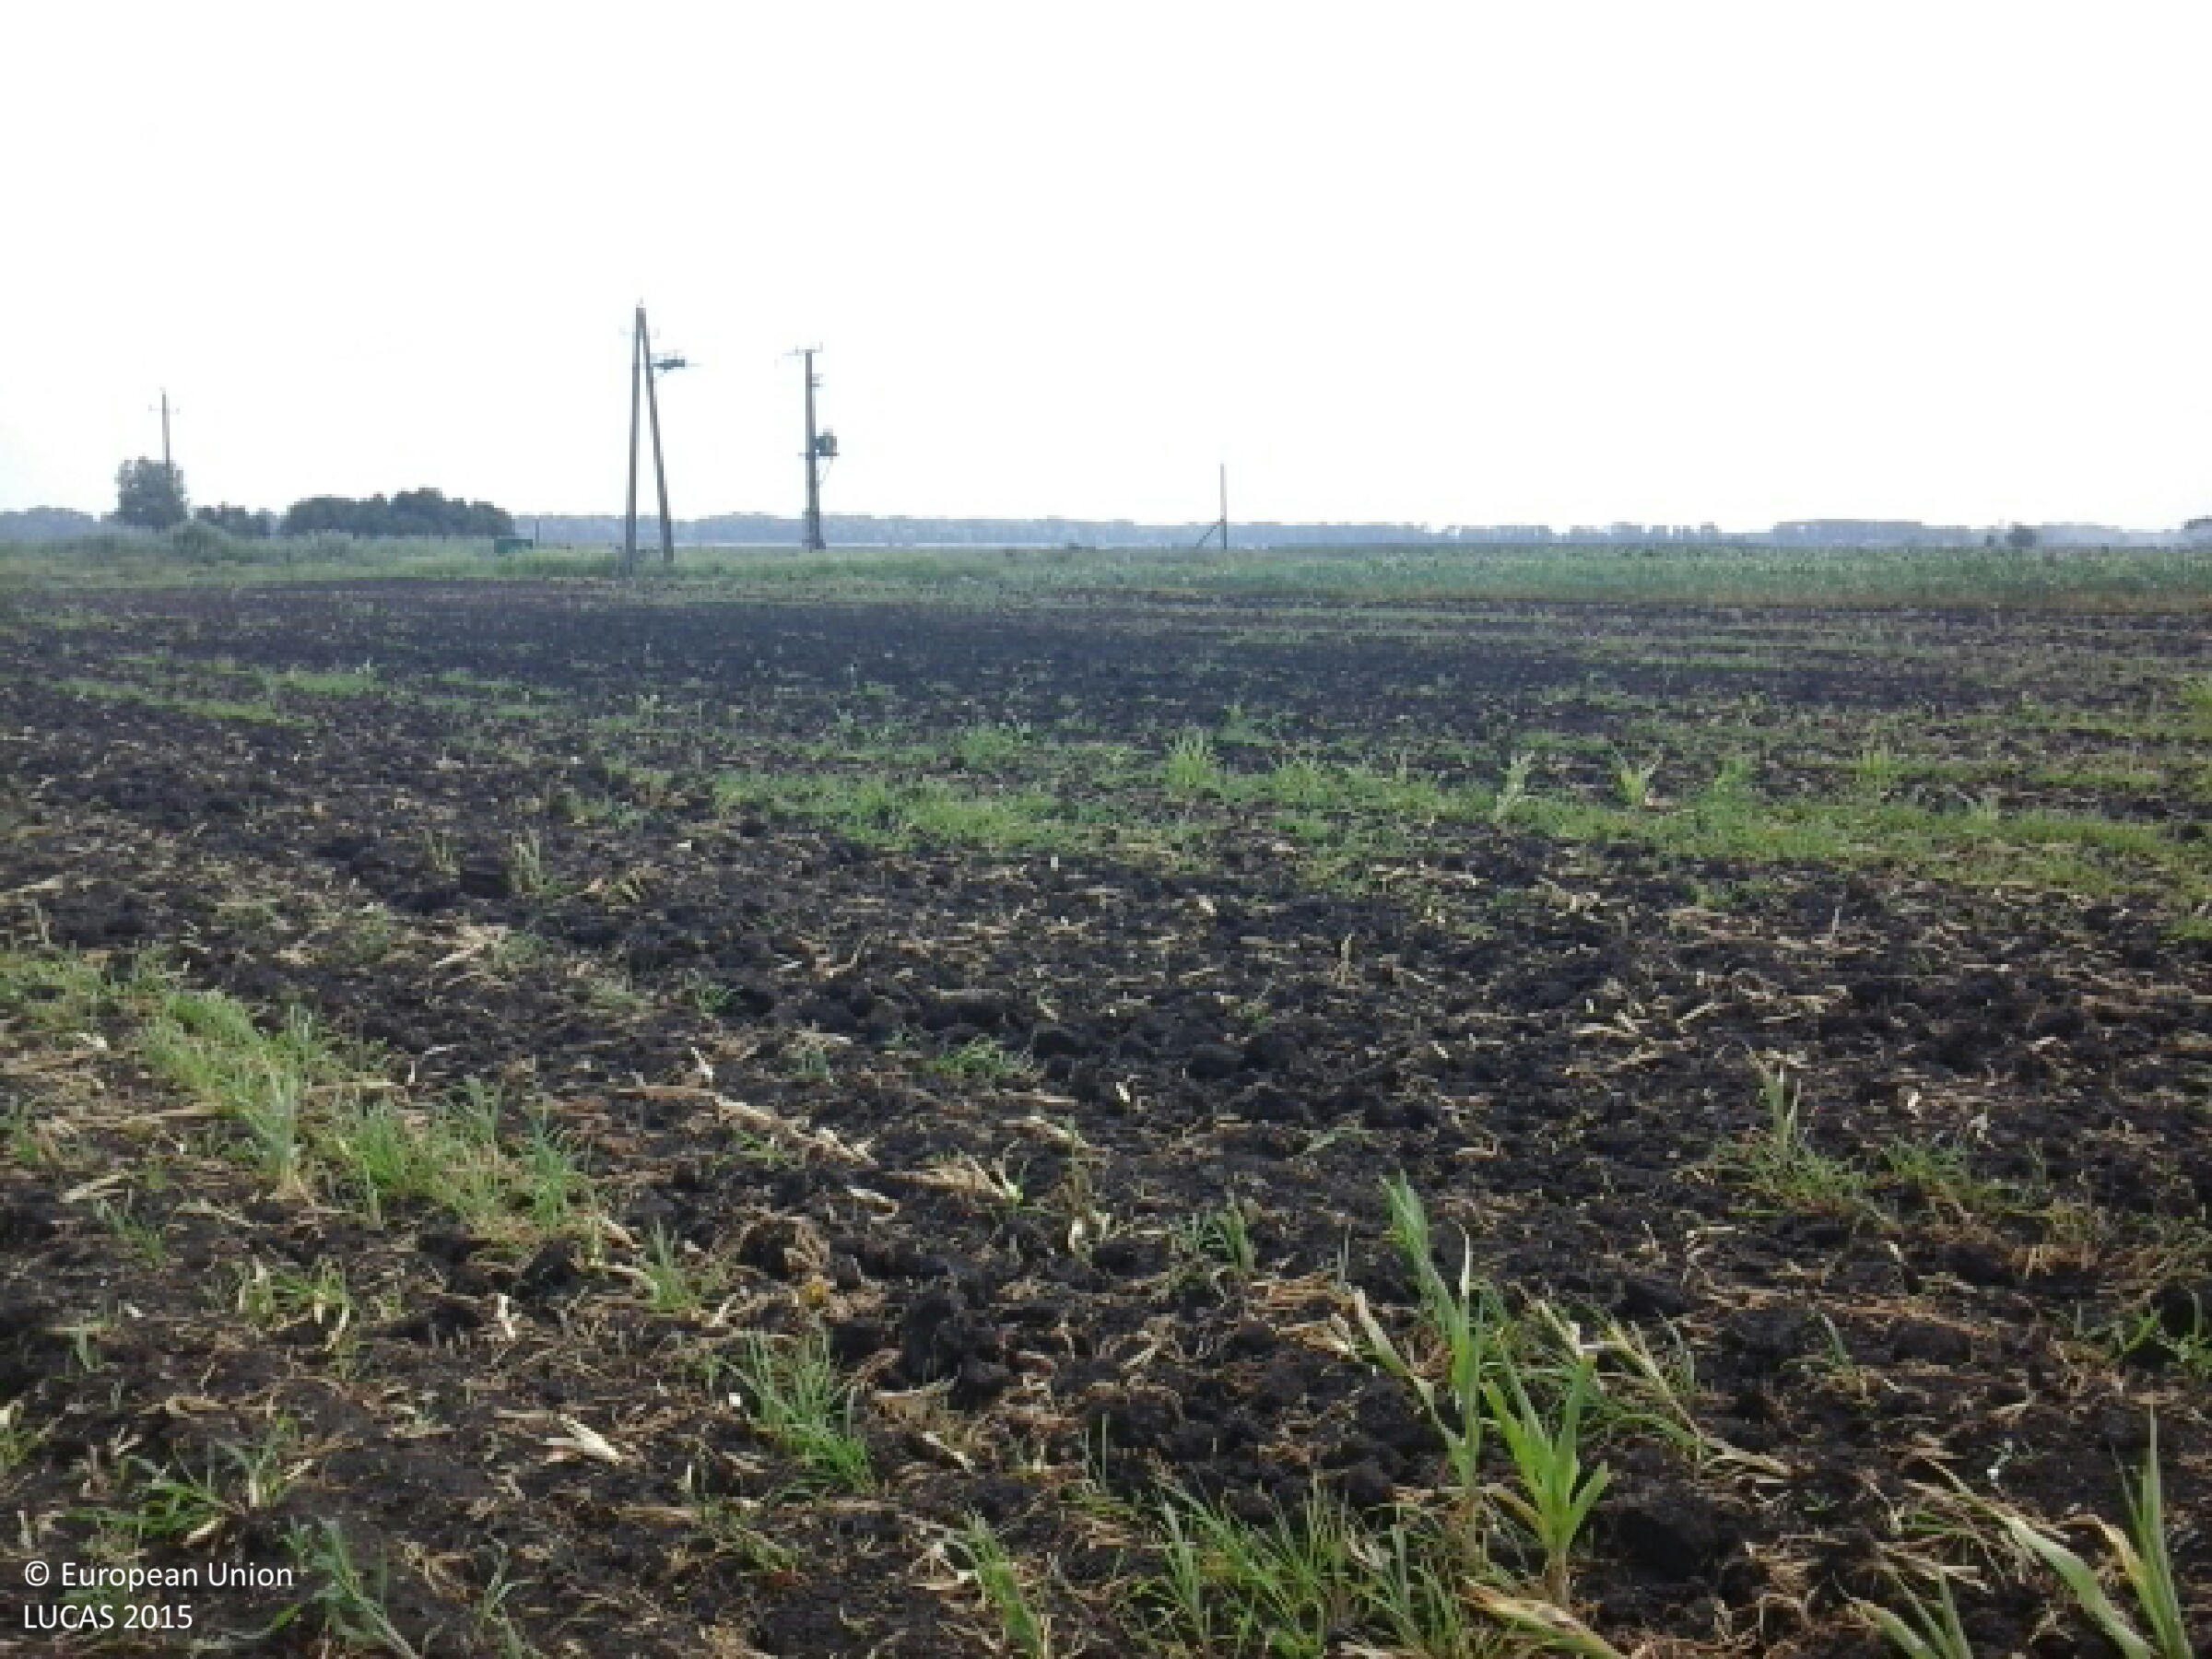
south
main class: Cropland
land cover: Maize
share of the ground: < 10 %
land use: Agriculture (excluding fallow land and kitchen gardens)
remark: Harvested field
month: June
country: HU
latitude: 48.2293
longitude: 21.7481
